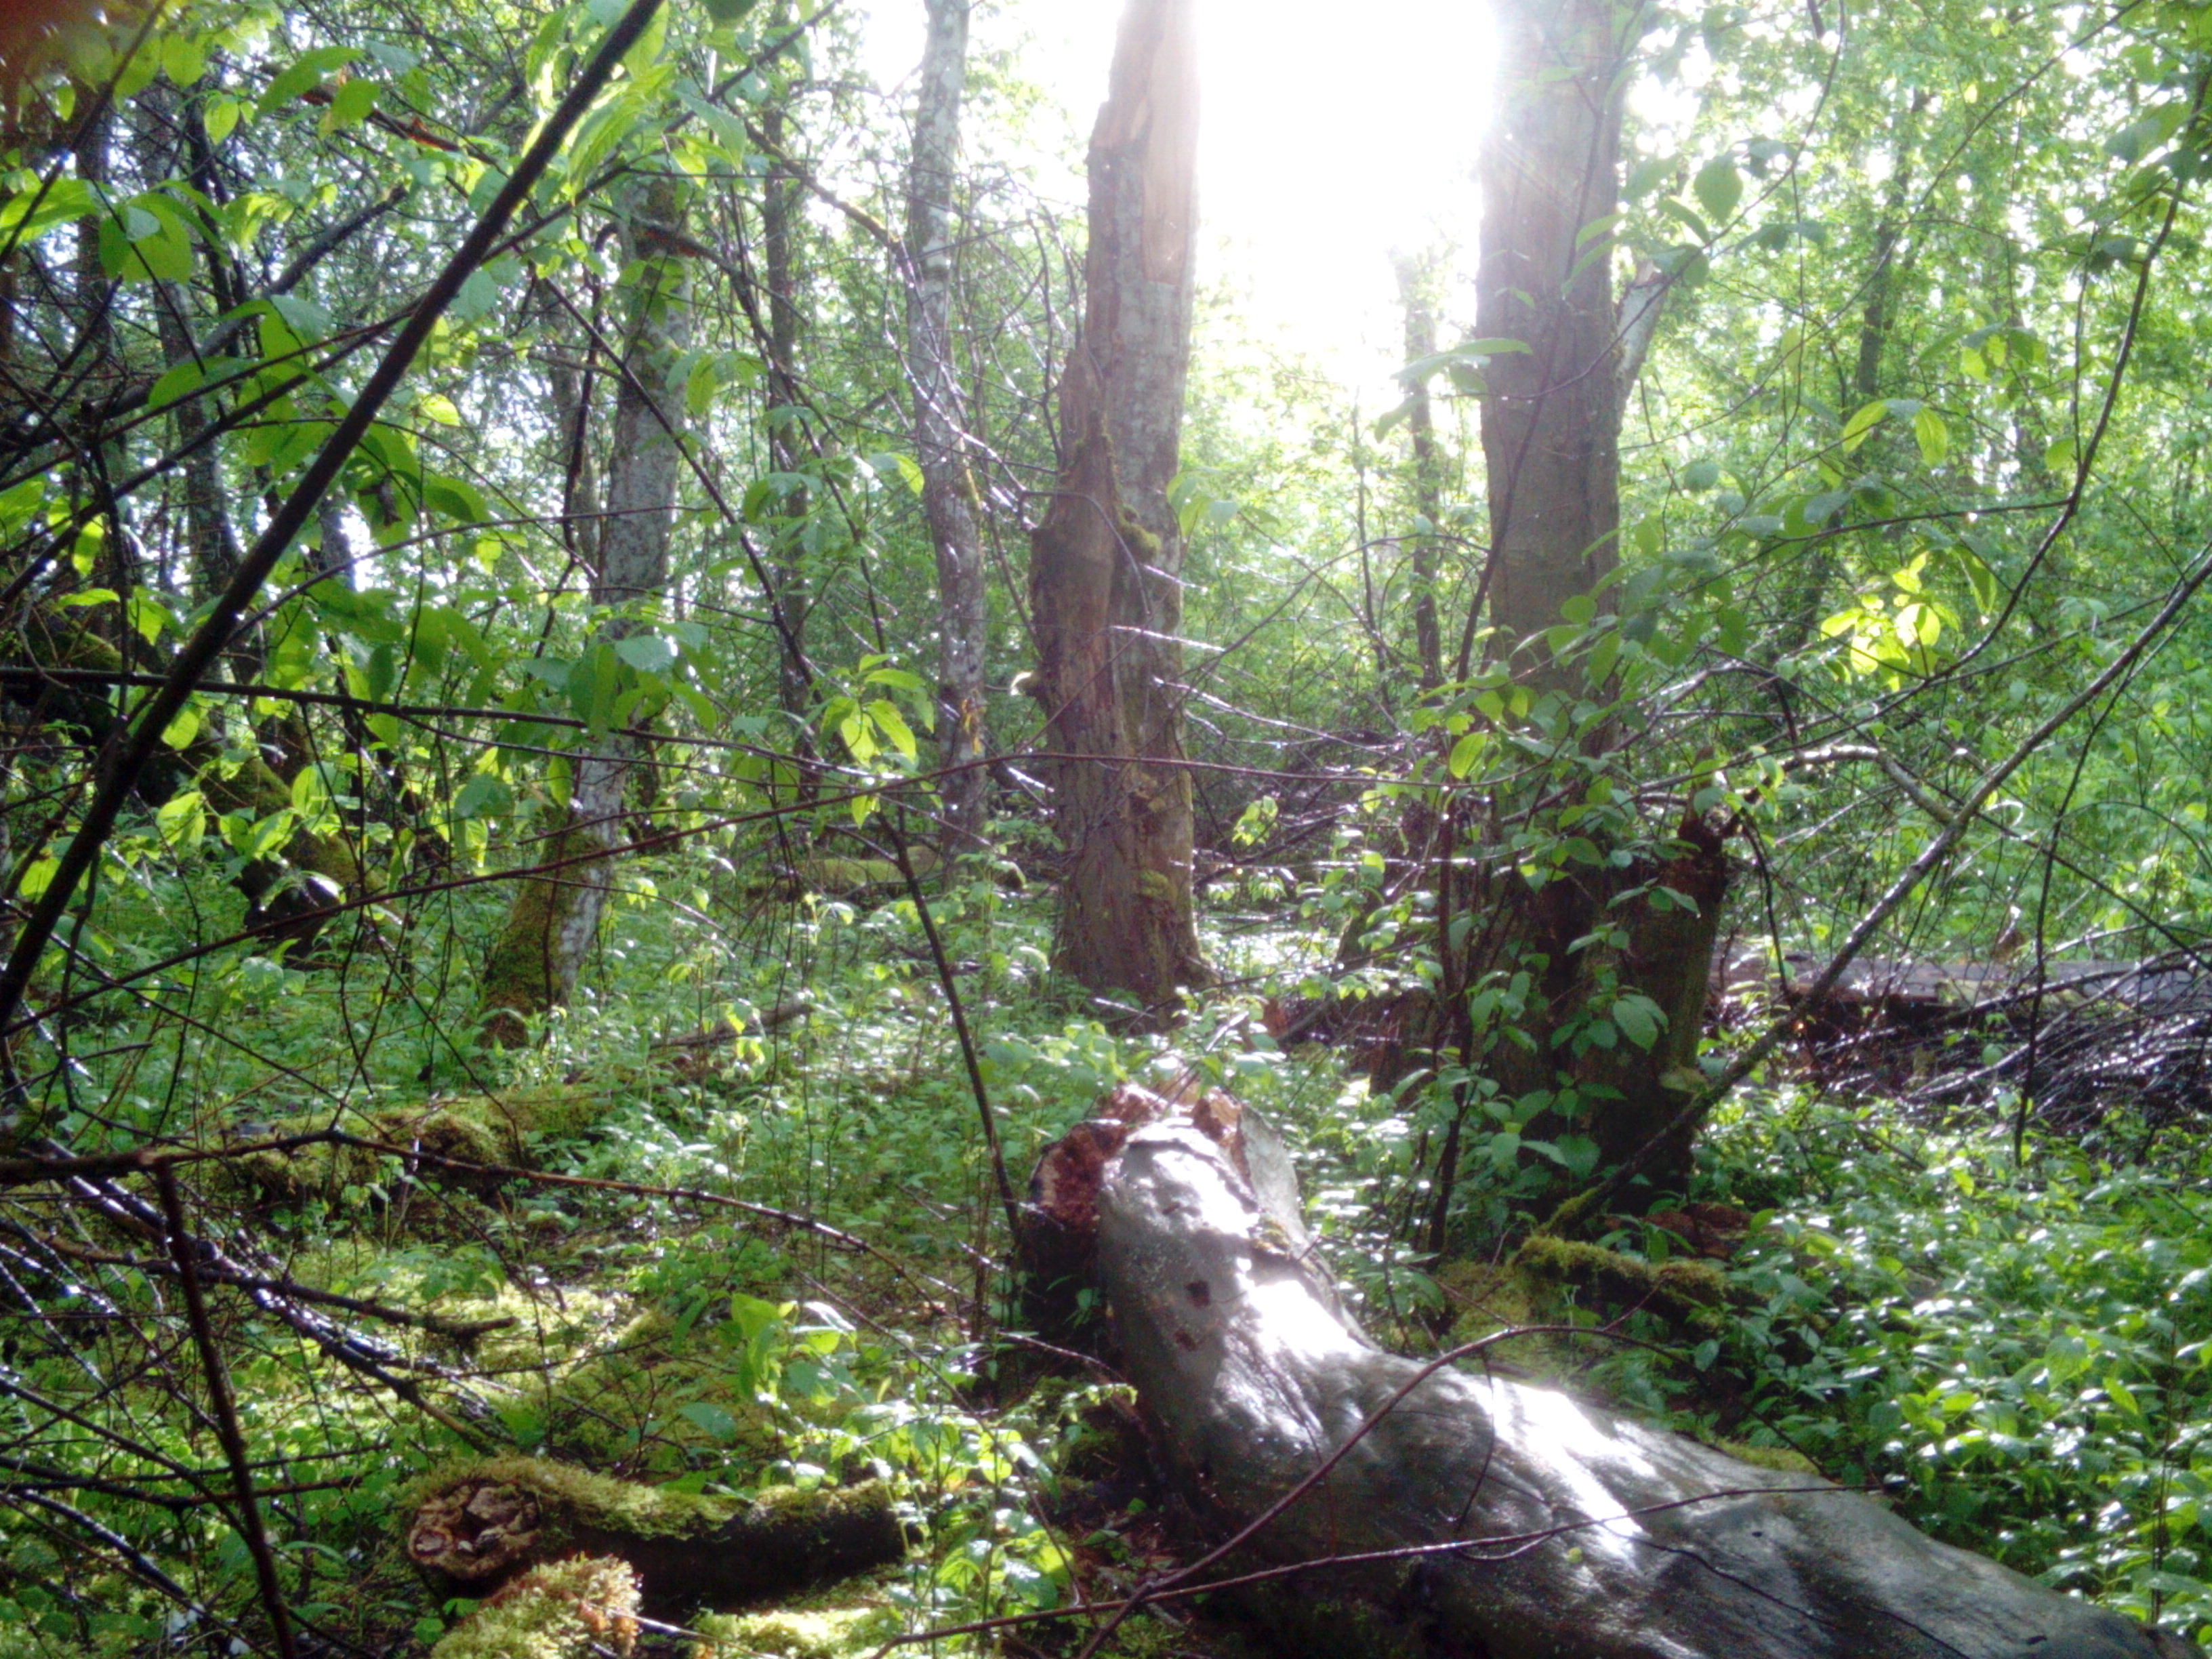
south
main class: Woodland
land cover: Broadleaved woodland
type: non-riverine alder, birch or aspen forest
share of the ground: > 75 %
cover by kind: broadleaved forest trees 80 %, coniferous forest trees 10 %, herbaceous plants 5 %, lichens and mosses 5 %
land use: Forestry
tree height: > 5 m
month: May
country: LV
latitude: 56.7468
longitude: 22.7993
